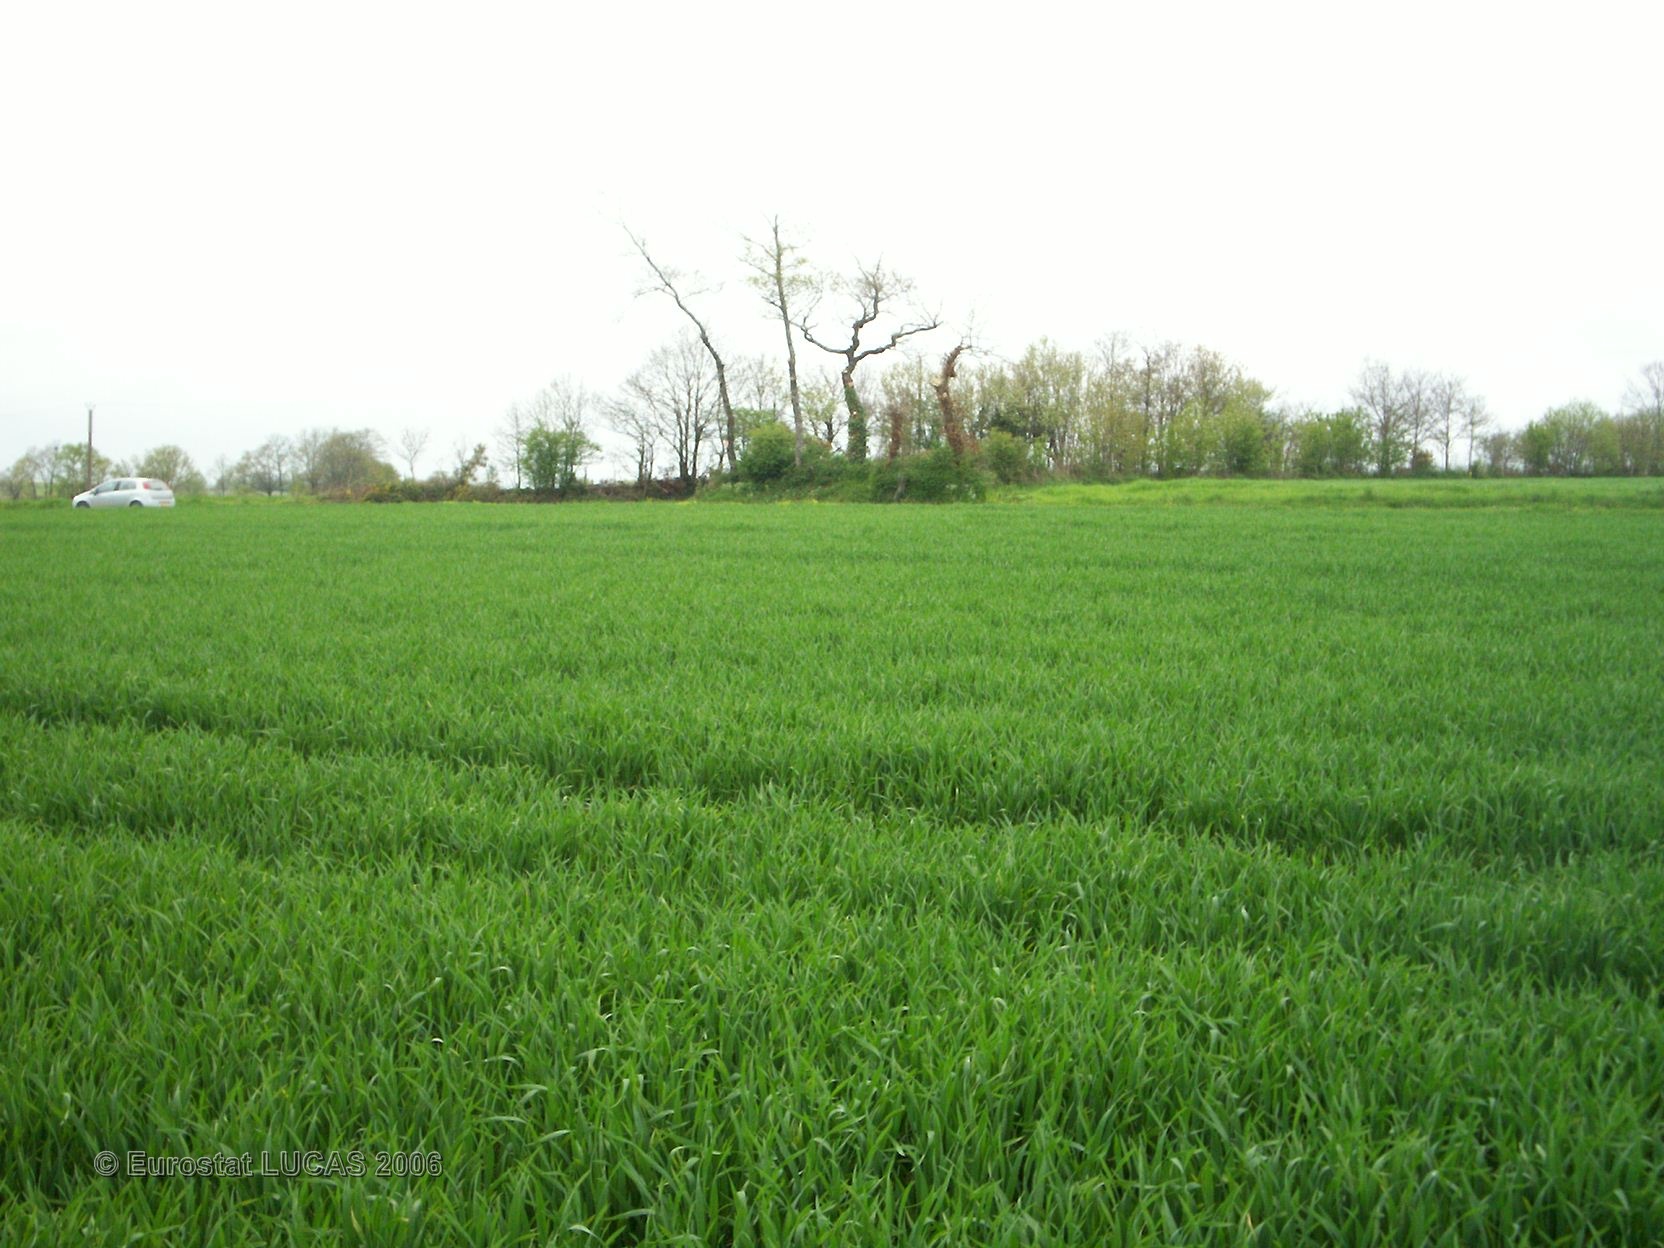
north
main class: Cropland
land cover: Common wheat
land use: Agriculture (excluding fallow land and kitchen gardens)
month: April
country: FR
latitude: 47.8680
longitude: -1.5557
